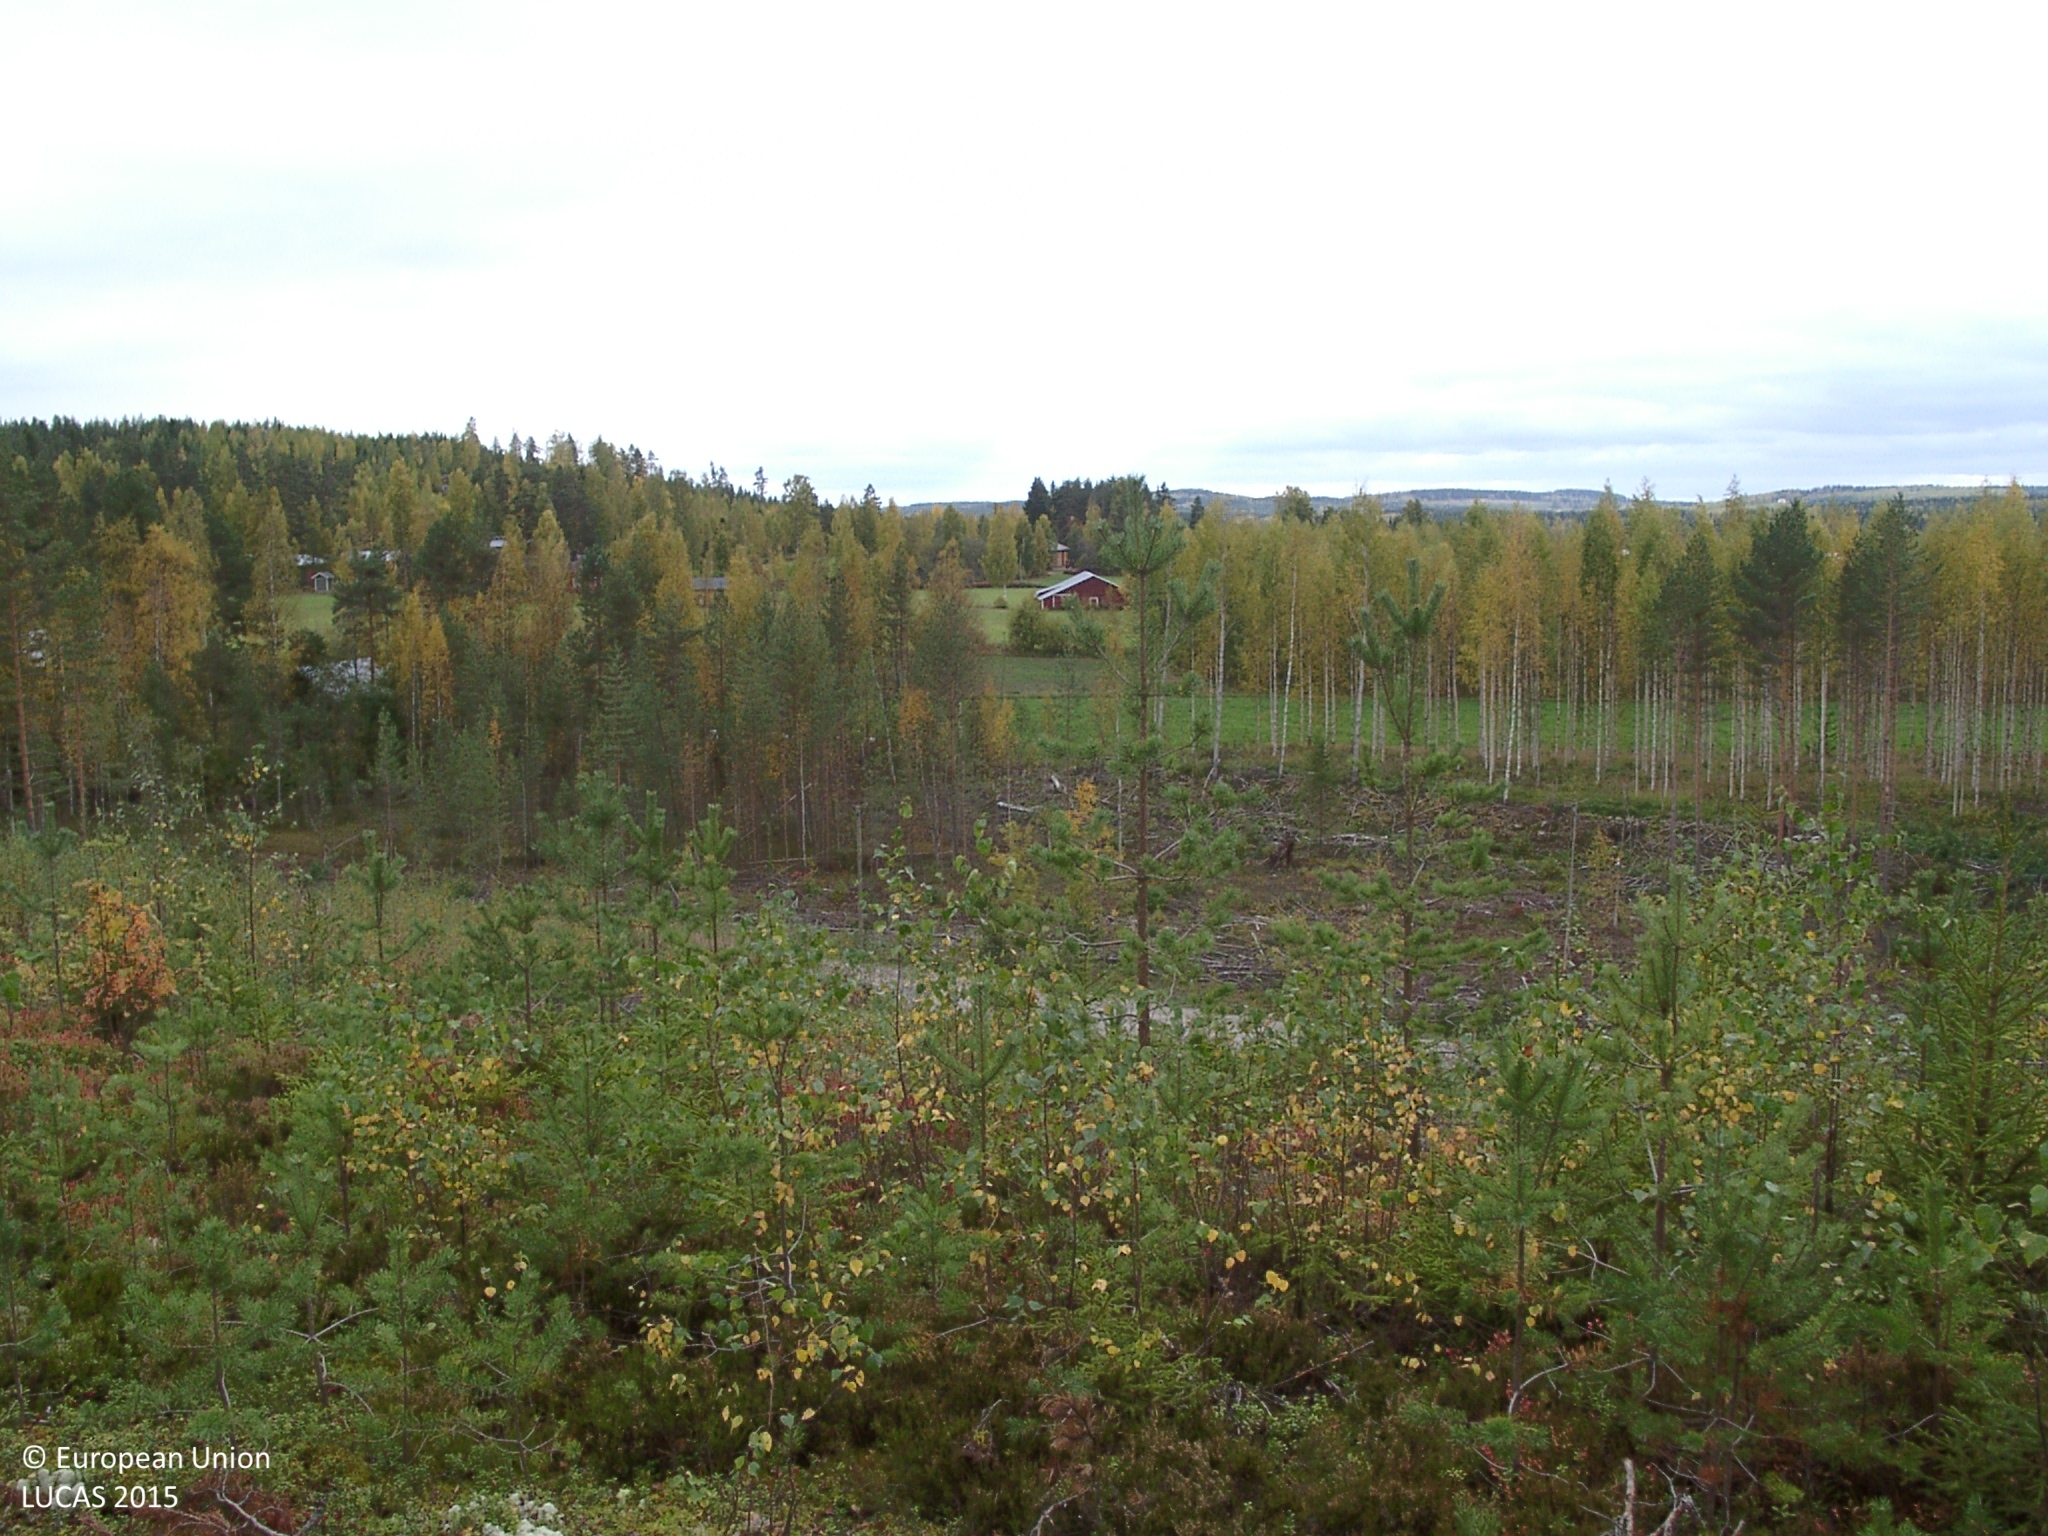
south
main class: Shrubland
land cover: Shrubland with sparse tree cover
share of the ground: 50 - 75 %
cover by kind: shrubs 60 %, lichens and mosses 30 %, coniferous forest trees 5 %
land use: Forestry
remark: Clear cut
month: September
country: FI
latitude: 62.6019
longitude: 25.4393
